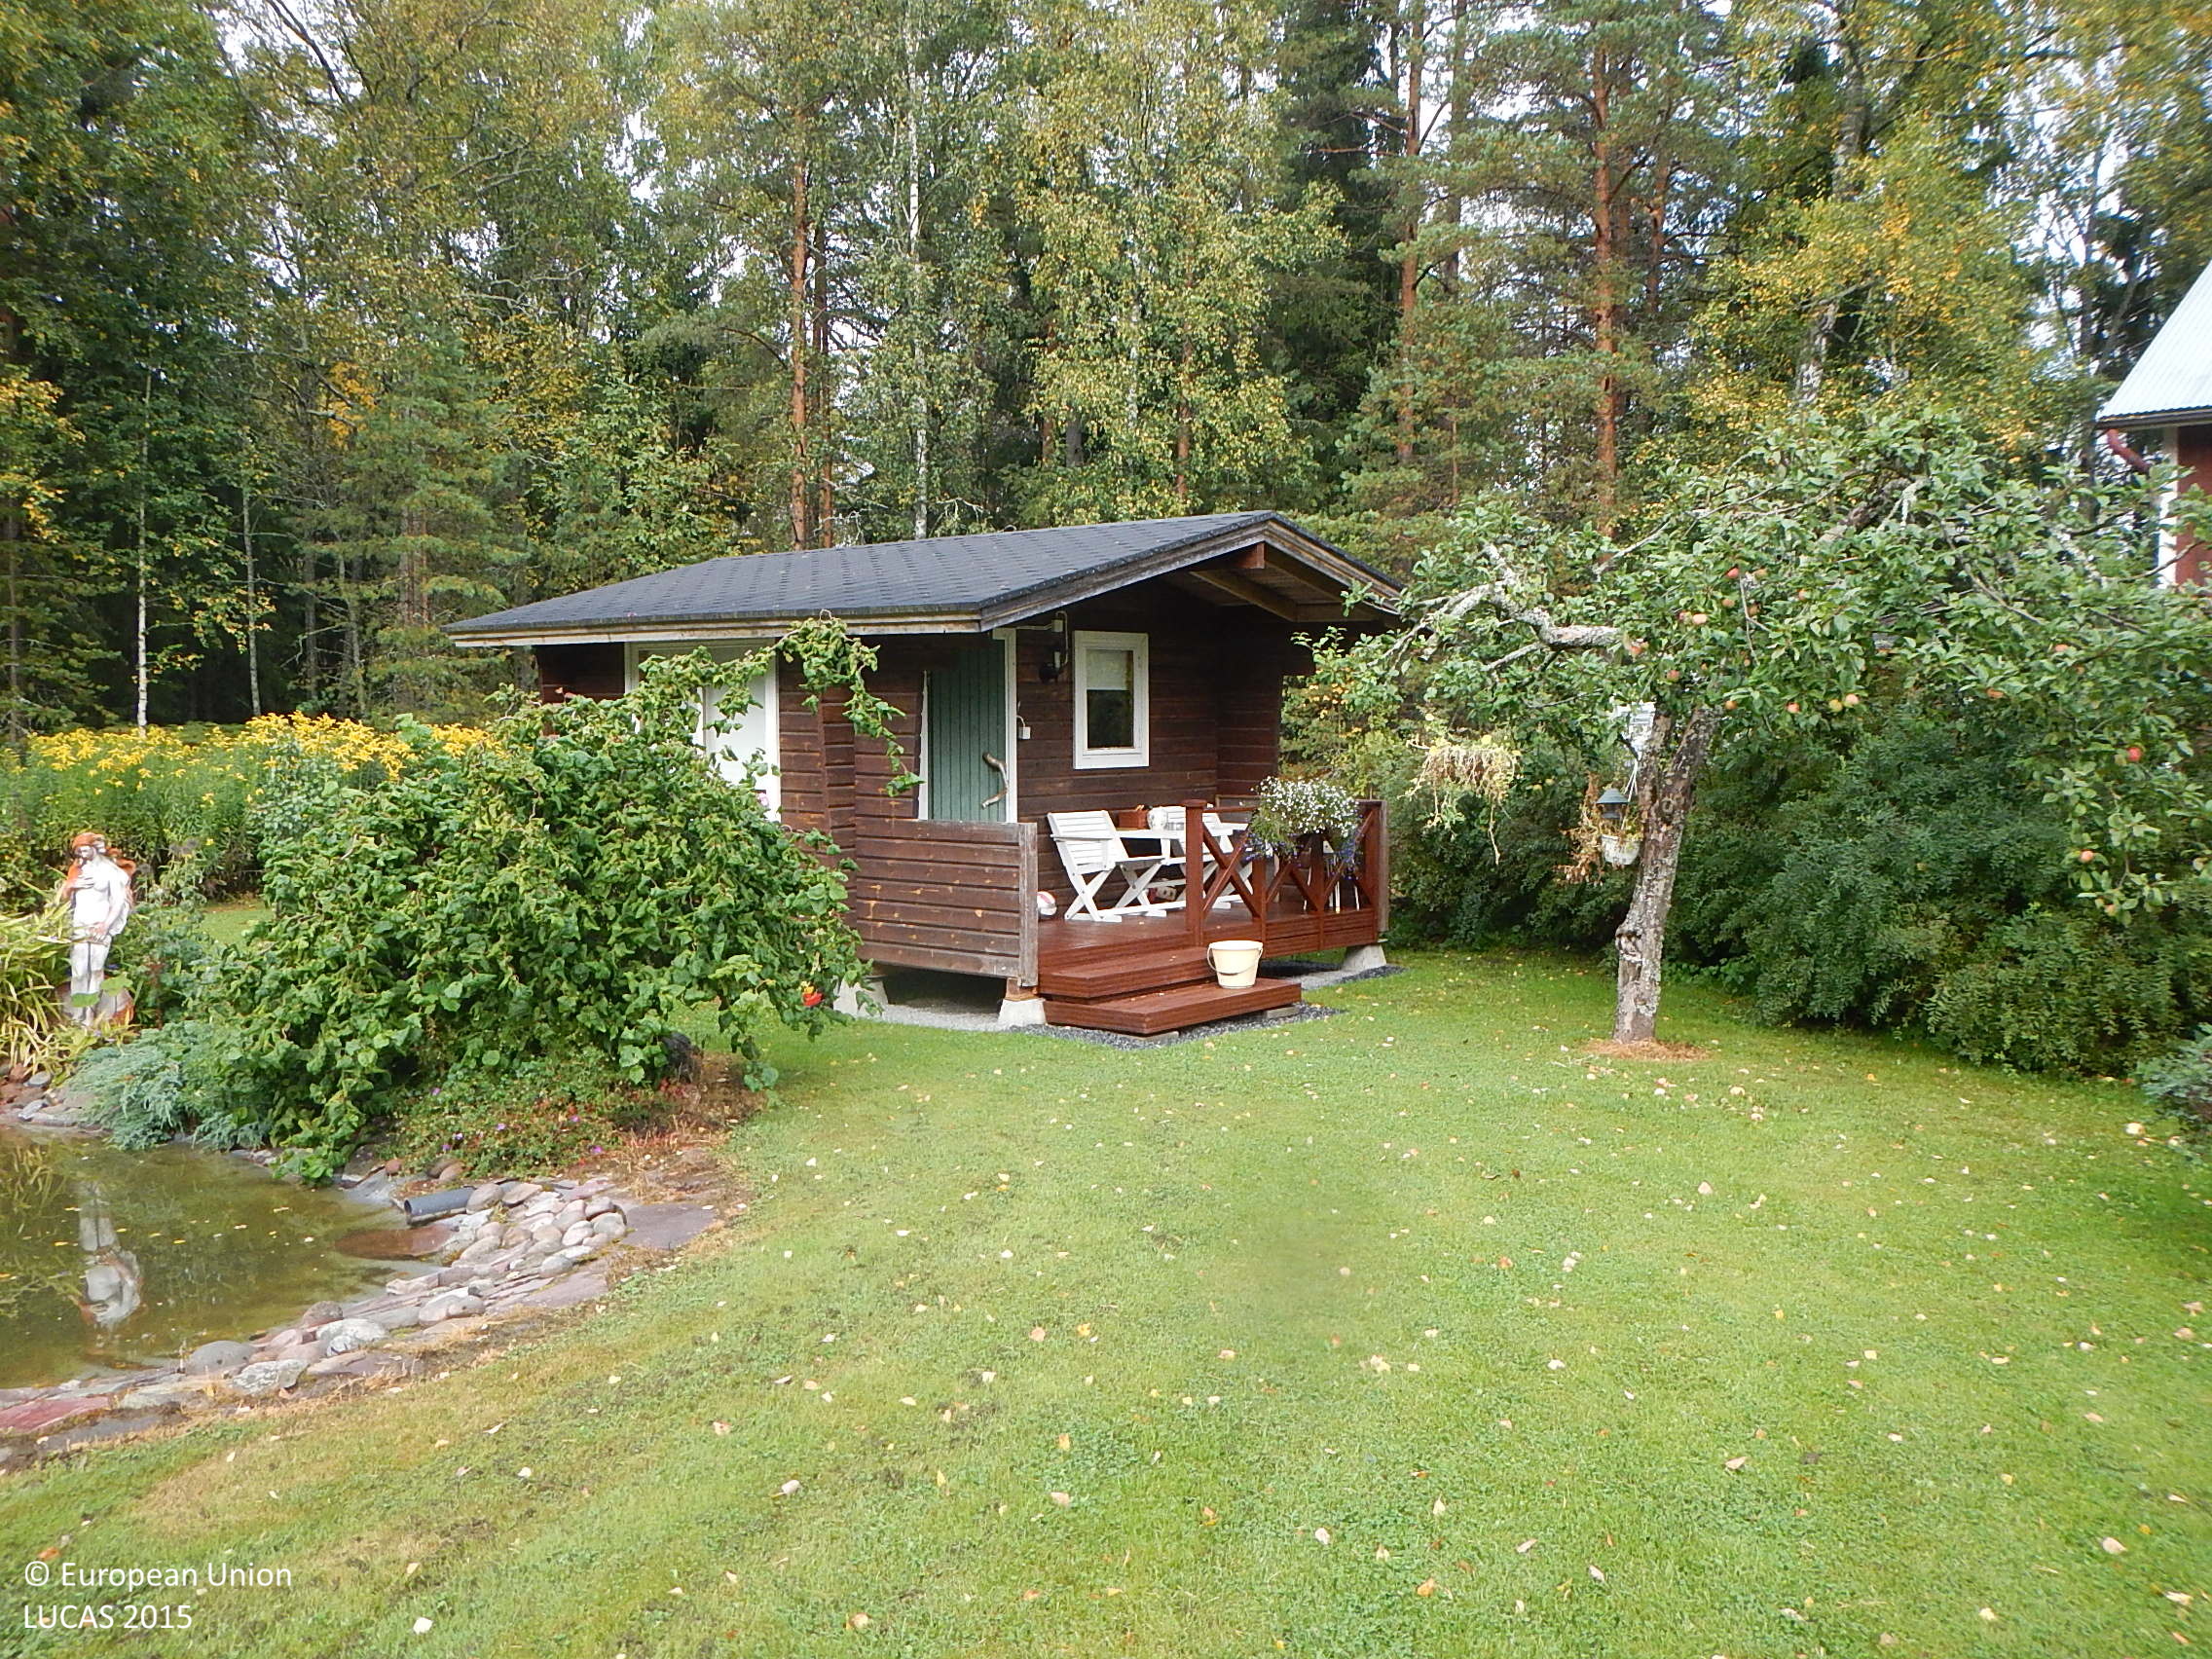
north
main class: Grassland
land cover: Grassland with sparse tree/shrub cover
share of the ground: > 75 %
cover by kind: herbaceous plants 95 %, broadleaved forest trees 5 %
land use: Residential
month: September
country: FI
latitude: 61.5610
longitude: 21.5899
